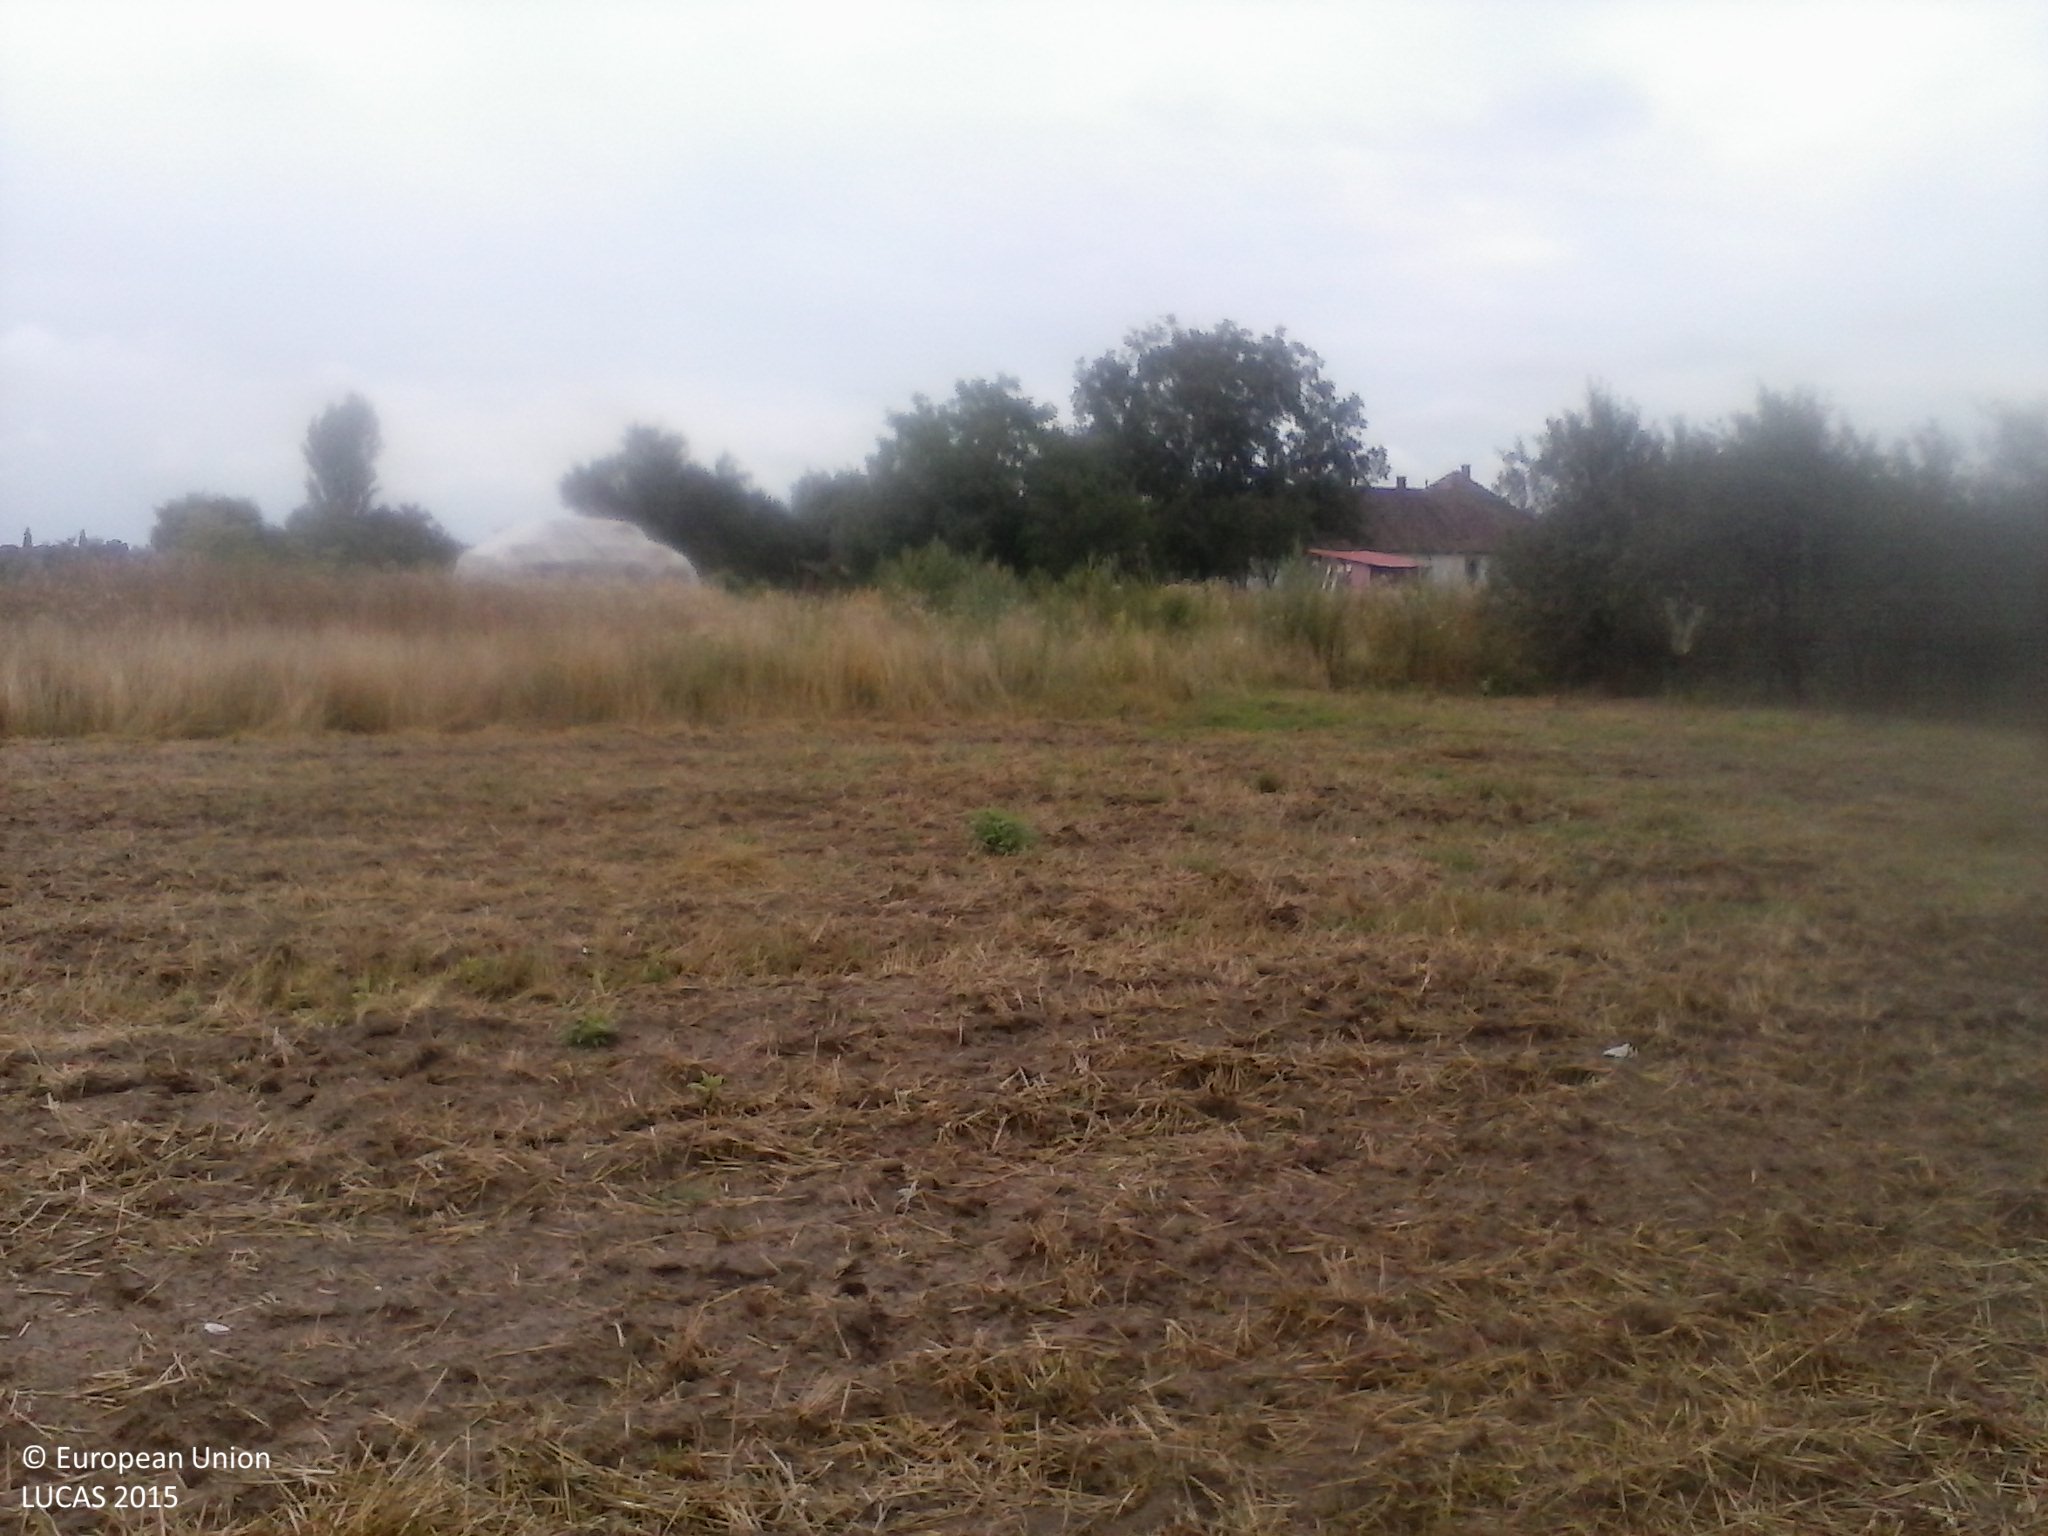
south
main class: Cropland
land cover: Common wheat
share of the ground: < 10 %
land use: Agriculture (excluding fallow land and kitchen gardens)
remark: Harvested field
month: July
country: HU
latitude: 45.9445
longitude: 17.7309
